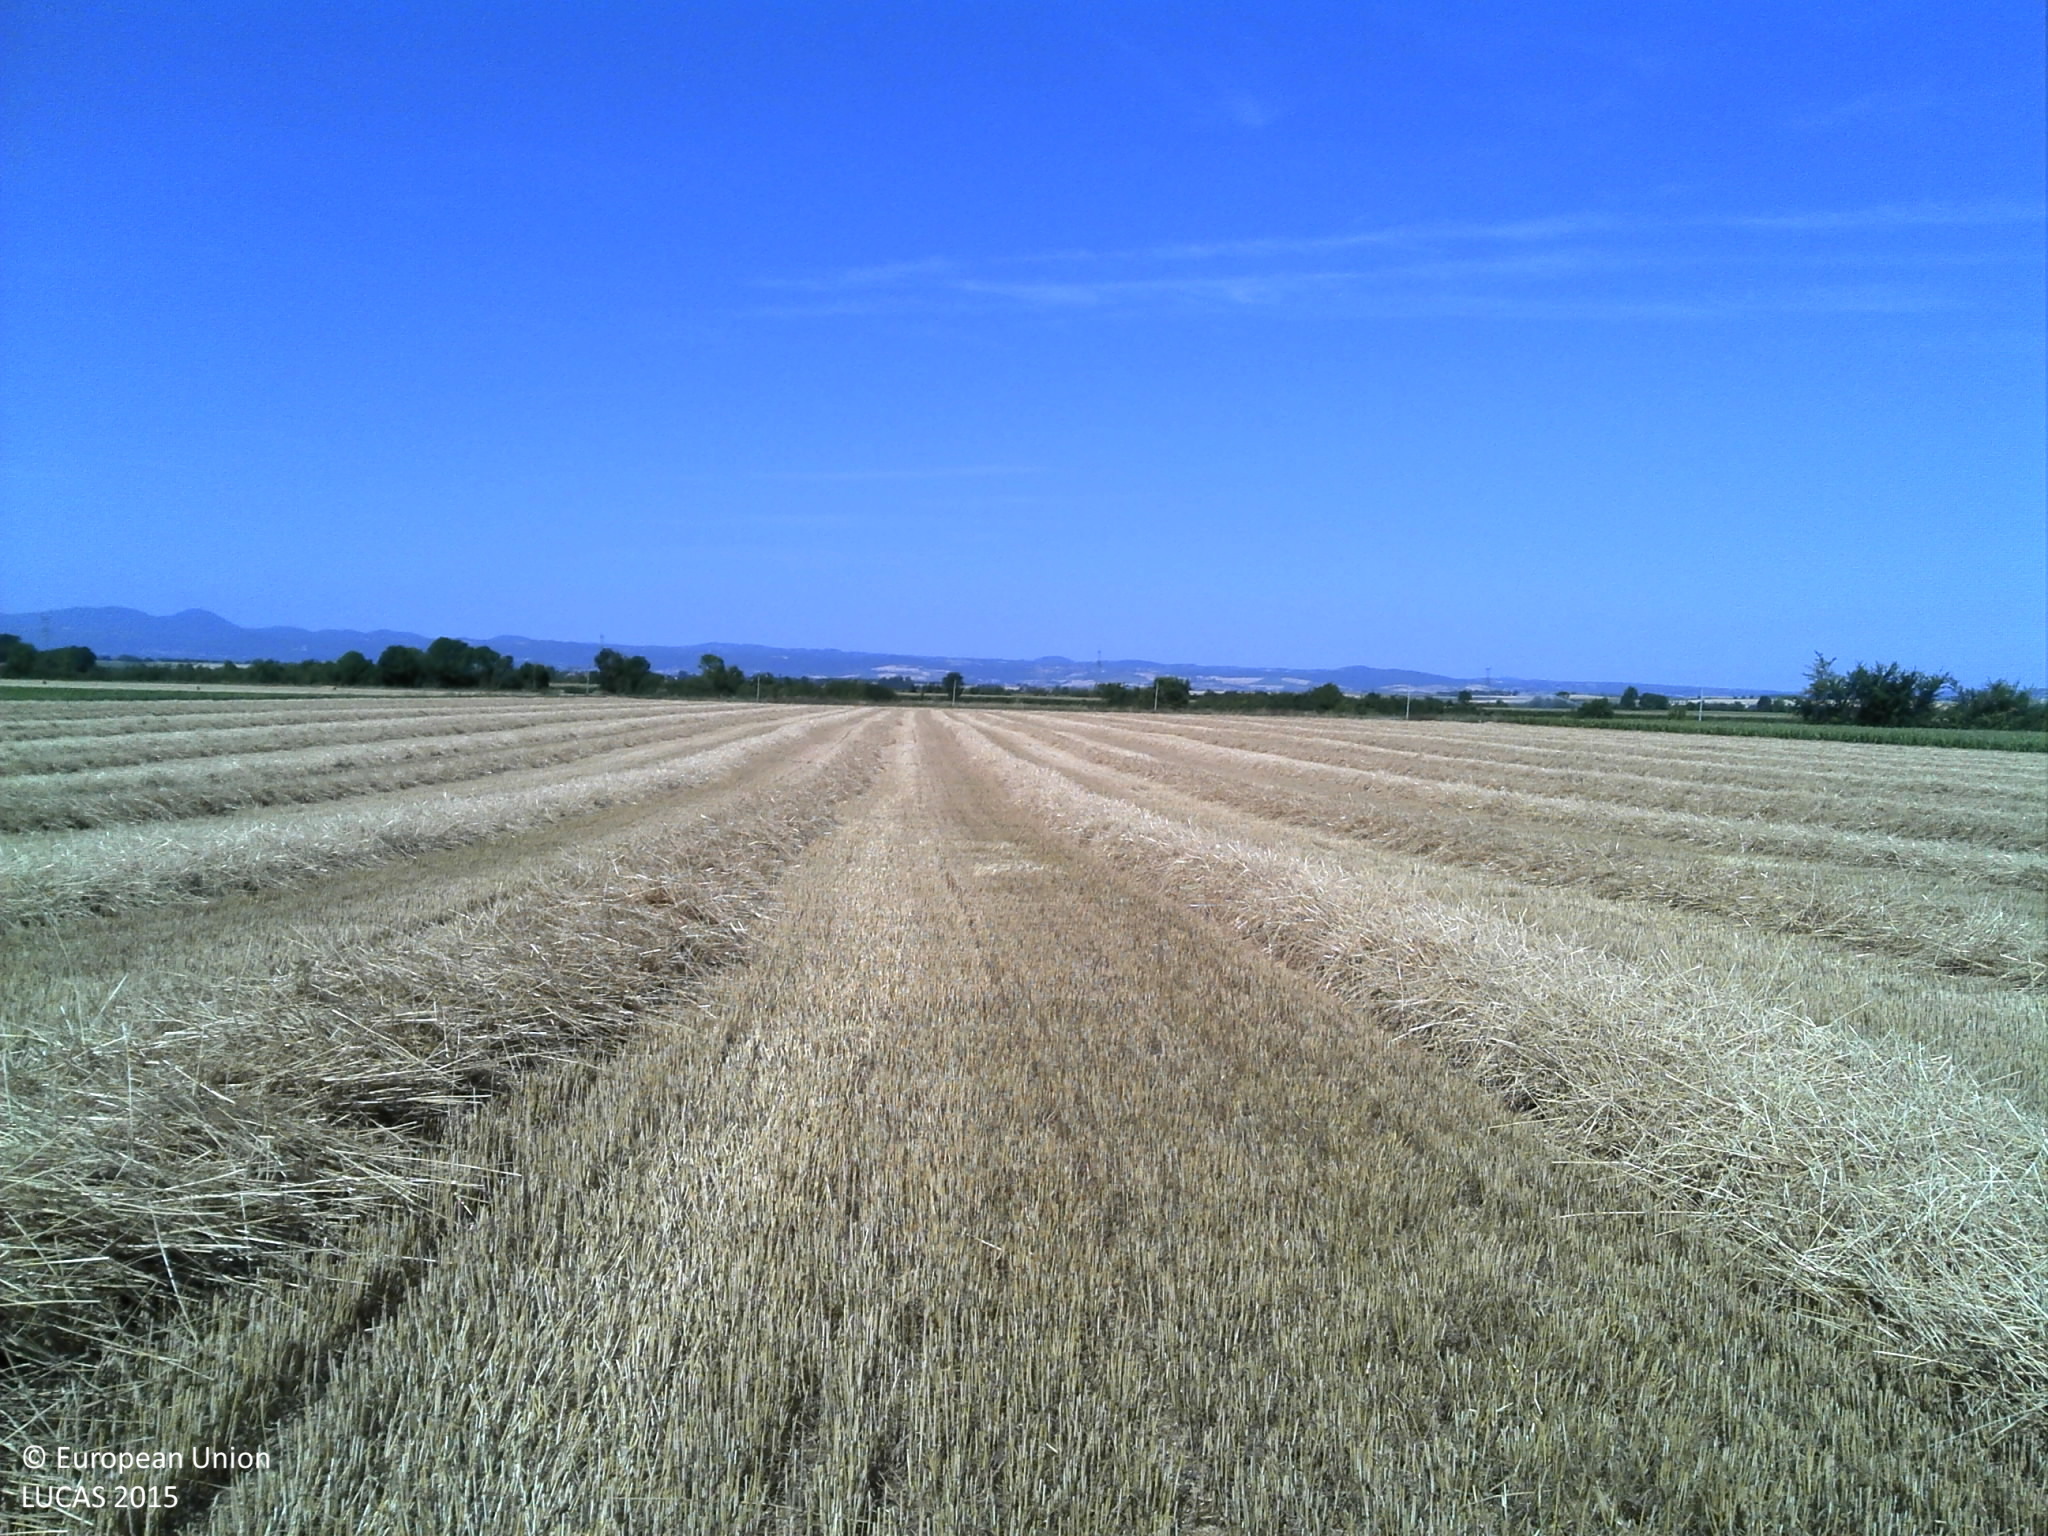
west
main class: Cropland
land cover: Common wheat
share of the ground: > 75 %
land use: Agriculture (excluding fallow land and kitchen gardens)
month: July
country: FR
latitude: 45.9426
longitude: 3.3052
